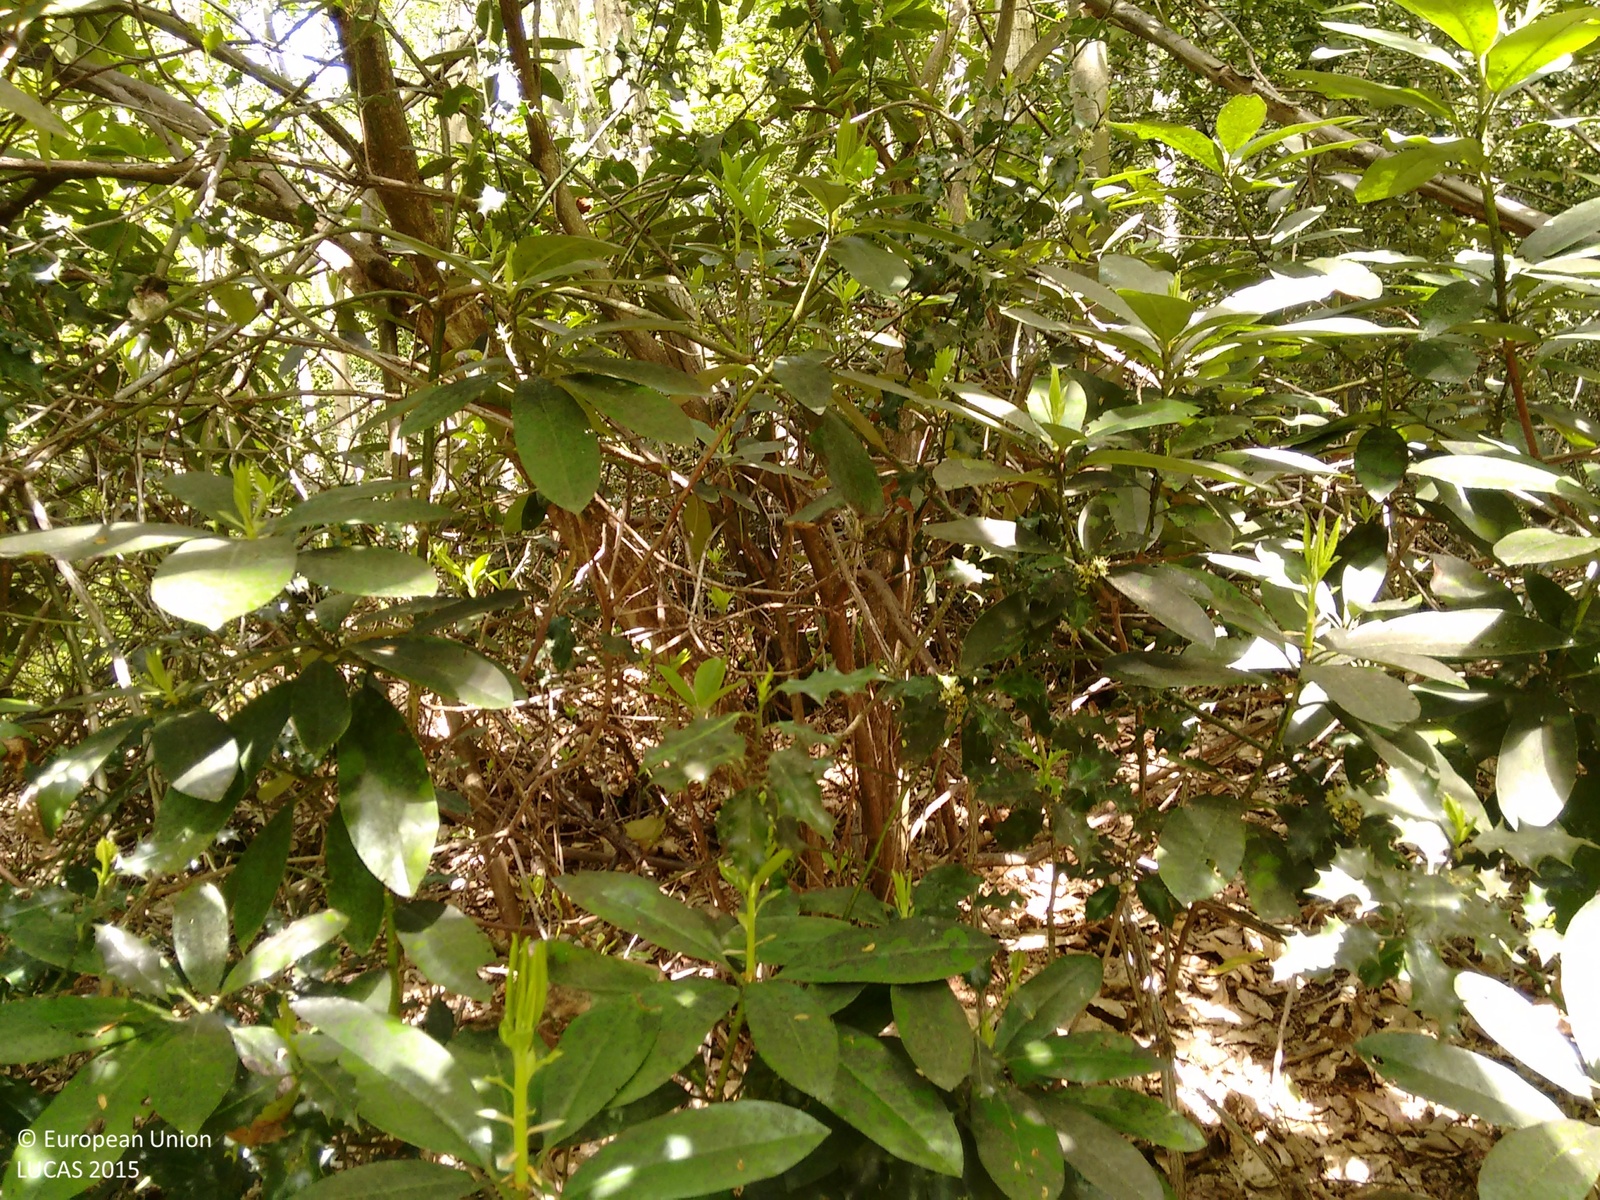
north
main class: Woodland
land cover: Broadleaved woodland
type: exotic forest
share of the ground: > 75 %
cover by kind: broadleaved forest trees 50 %, shrubs 50 %
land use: Amenities, museums, leisure
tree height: > 5 m
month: May
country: GB
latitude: 51.1457
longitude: 0.2927
